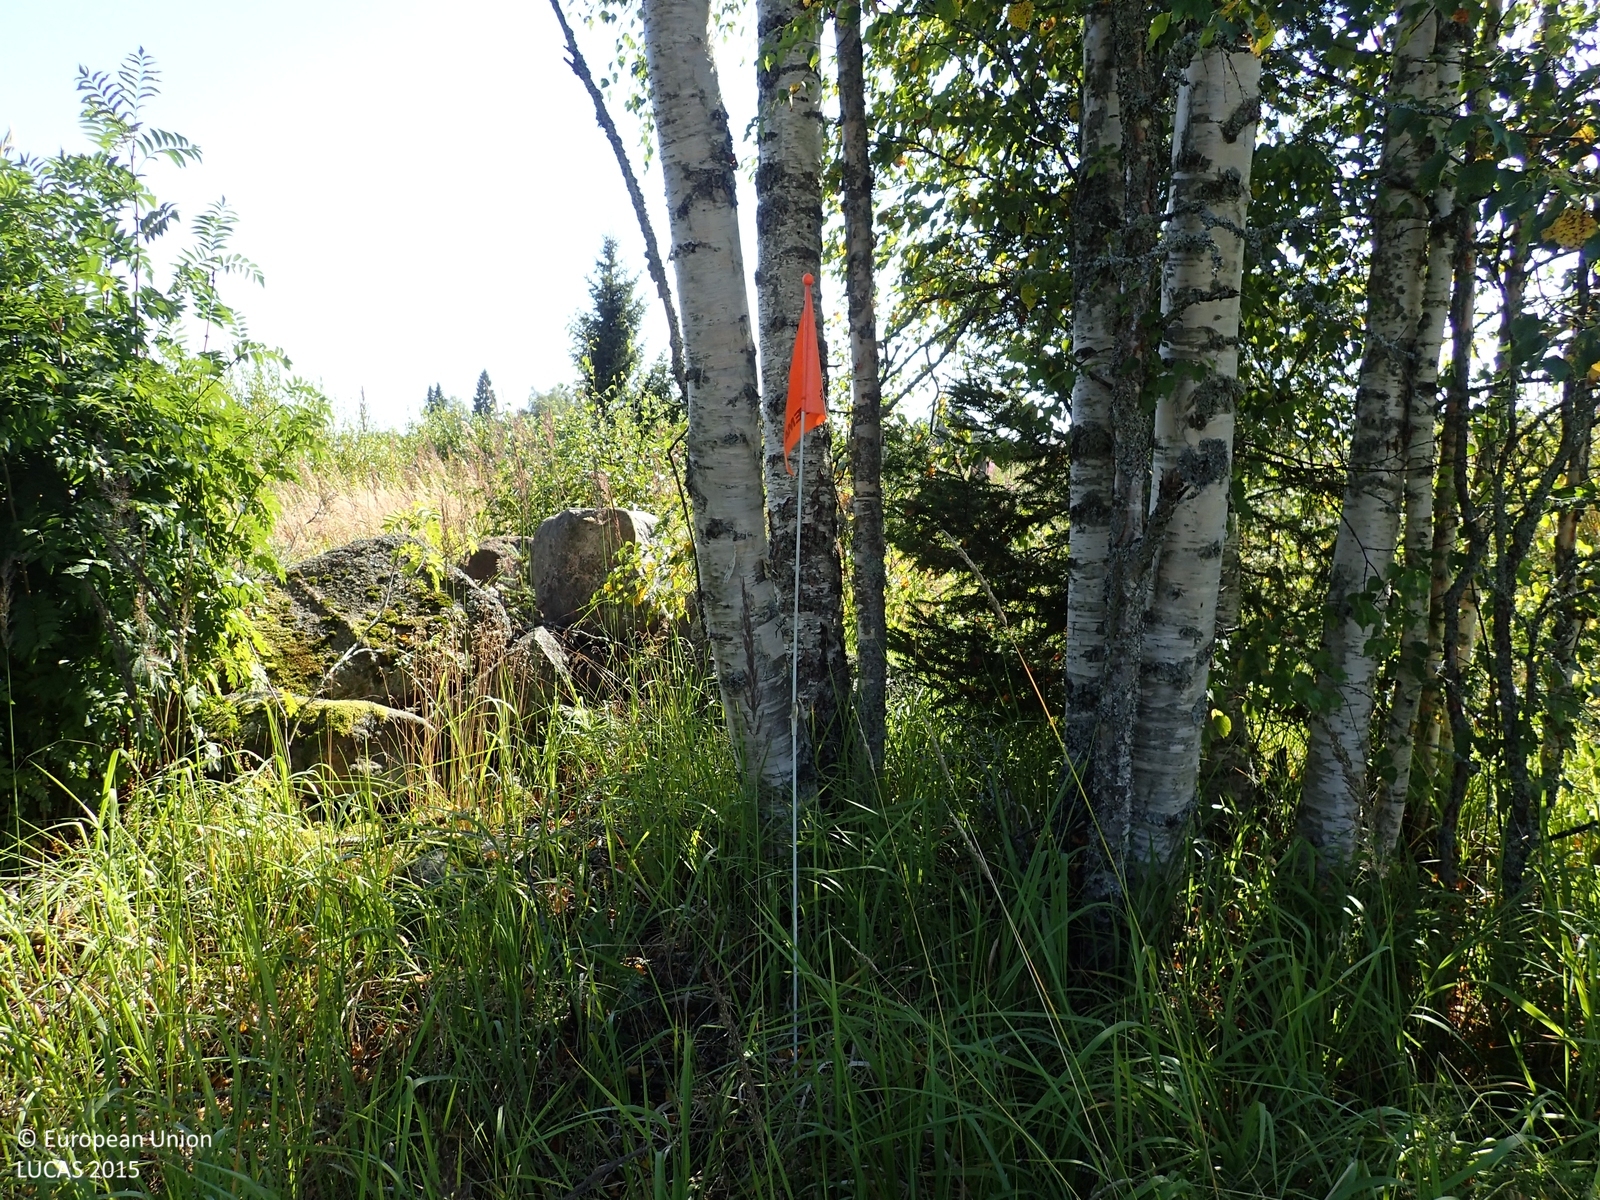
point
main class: Woodland
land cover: Broadleaved woodland
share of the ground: 25 - 50 %
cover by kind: herbaceous plants 60 %, broadleaved forest trees 40 %
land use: Residential
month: August
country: FI
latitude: 62.3261
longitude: 21.8410
